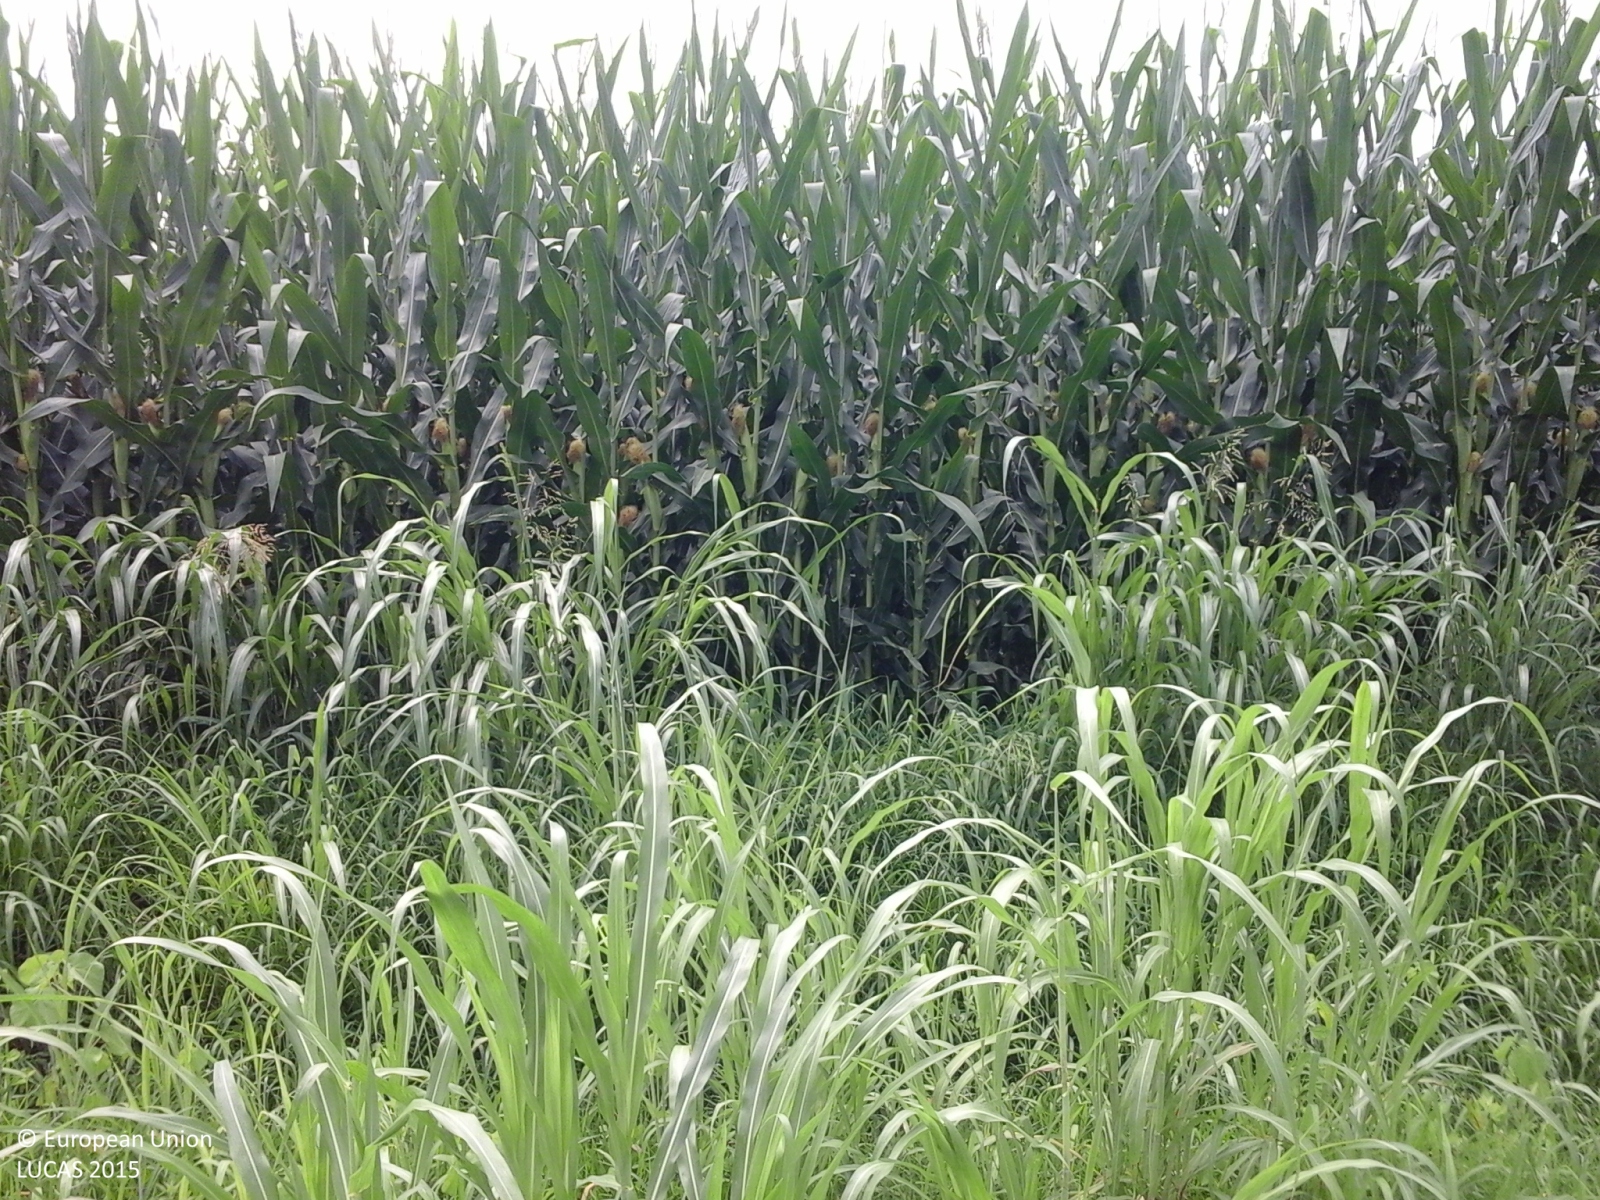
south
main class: Cropland
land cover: Maize
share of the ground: > 75 %
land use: Agriculture (excluding fallow land and kitchen gardens)
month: July
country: IT
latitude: 45.1564
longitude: 8.9208
